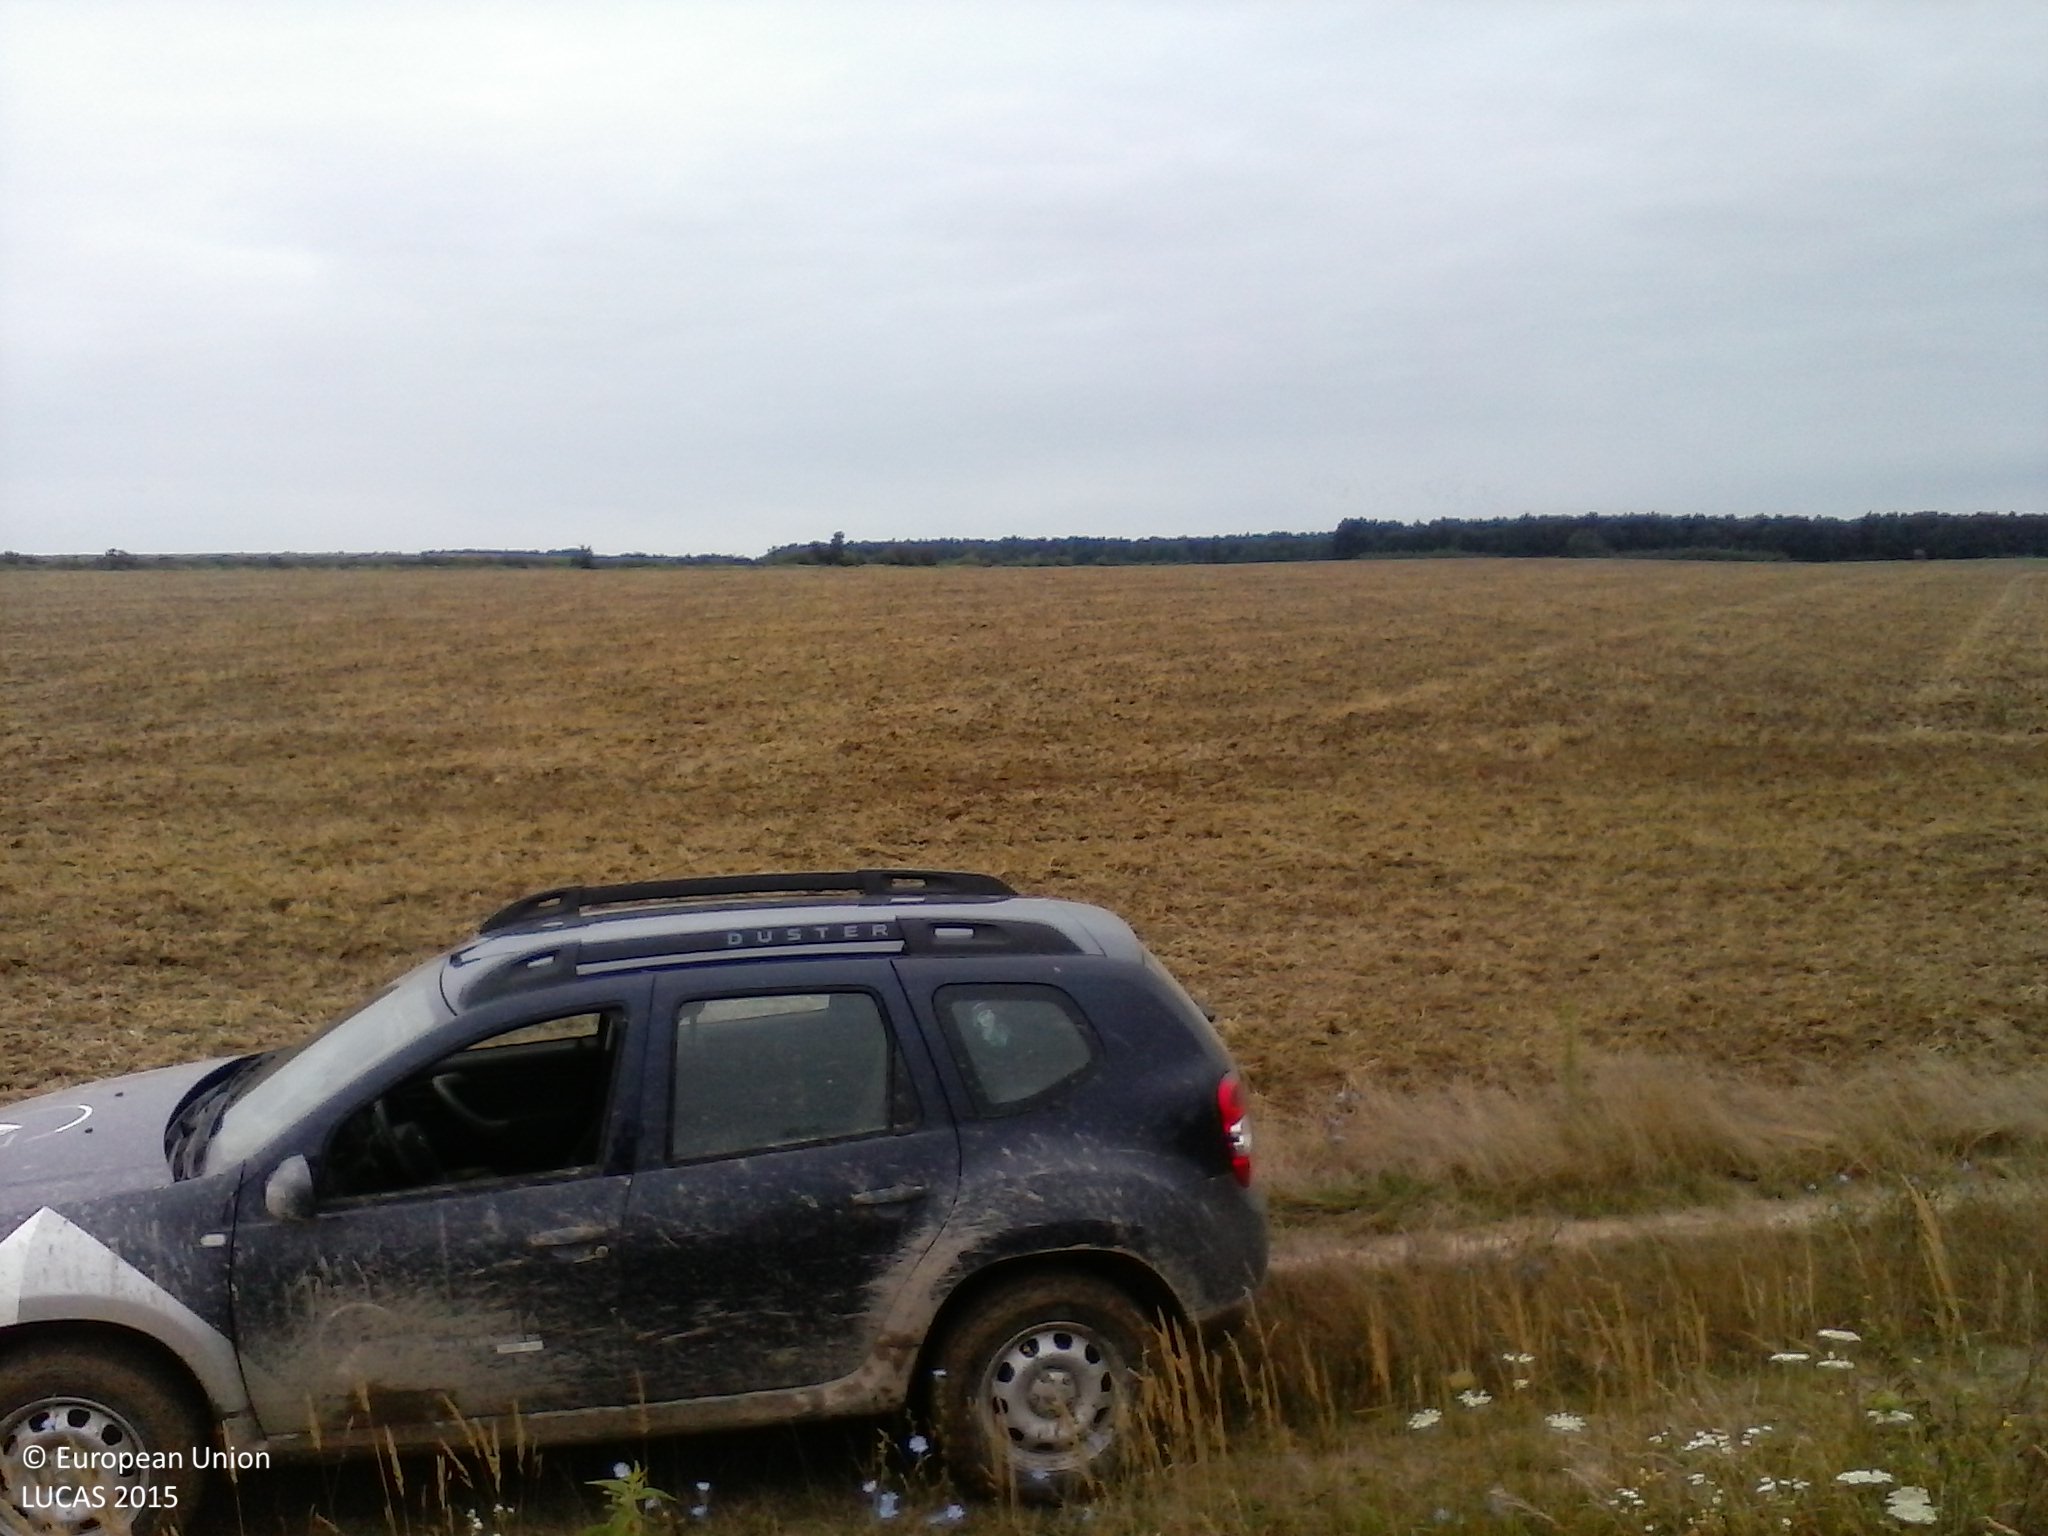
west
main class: Cropland
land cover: Maize
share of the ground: > 75 %
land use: Agriculture (excluding fallow land and kitchen gardens)
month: July
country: HU
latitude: 46.1131
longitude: 17.6512
